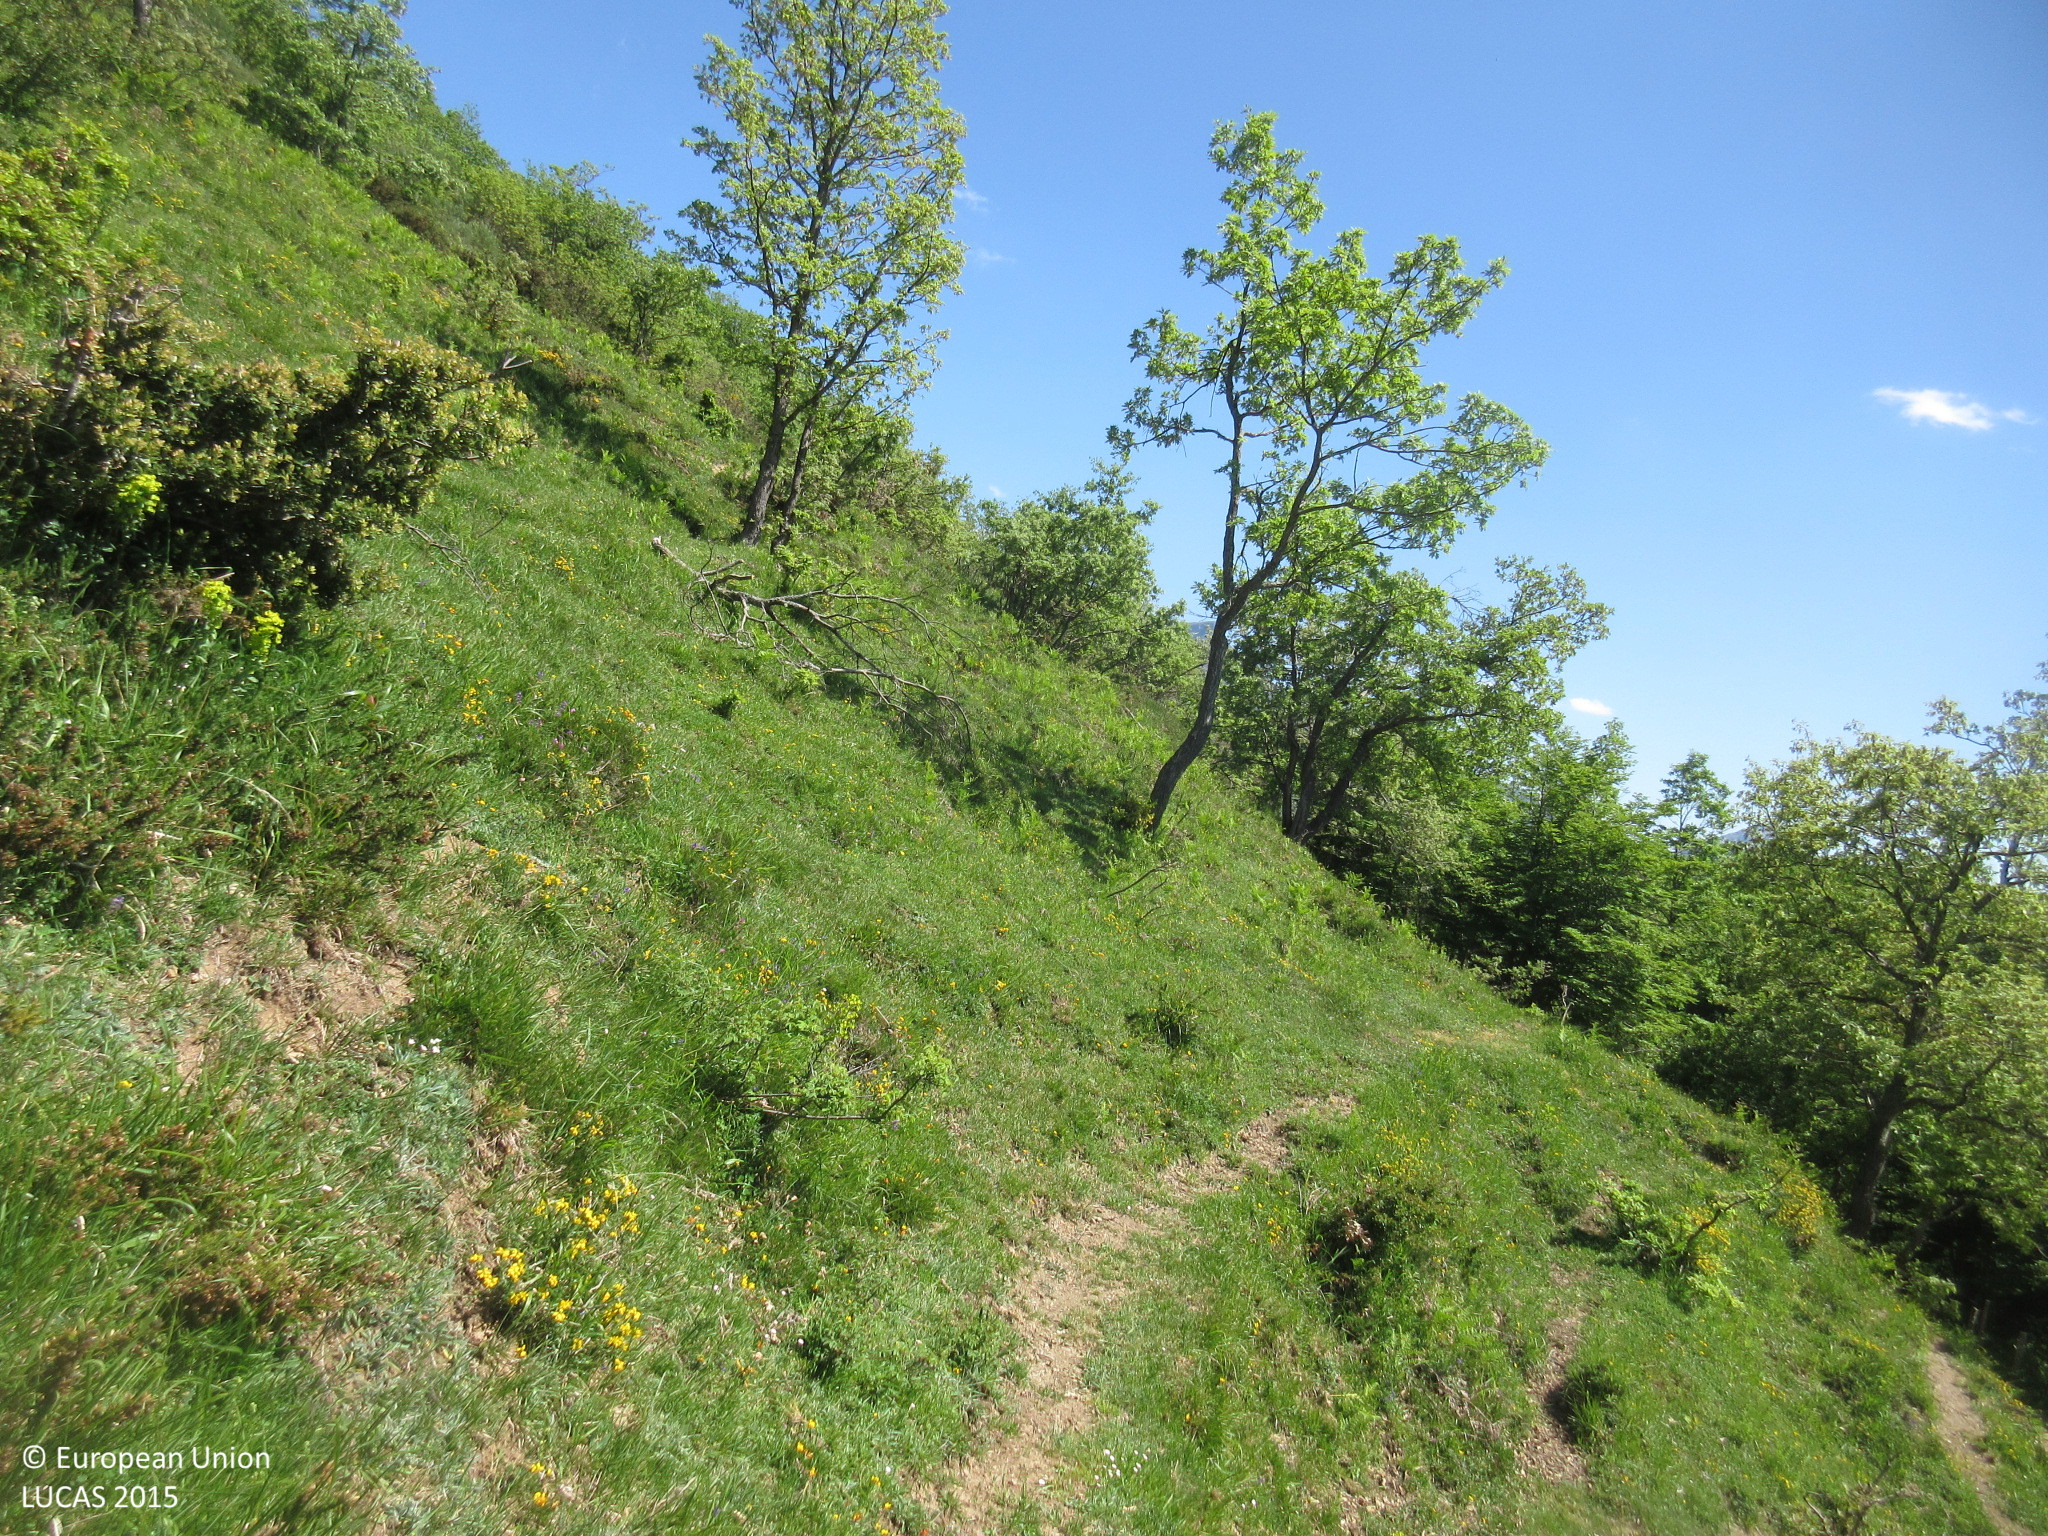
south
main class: Woodland
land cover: Broadleaved woodland
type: acidophilous oak and oak-birch forest
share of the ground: > 75 %
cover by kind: broadleaved forest trees 80 %, shrubs 10 %, herbaceous plants 10 %
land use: Agriculture (excluding fallow land and kitchen gardens)
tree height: > 5 m
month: June
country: ES
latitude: 43.0925
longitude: -4.4674
